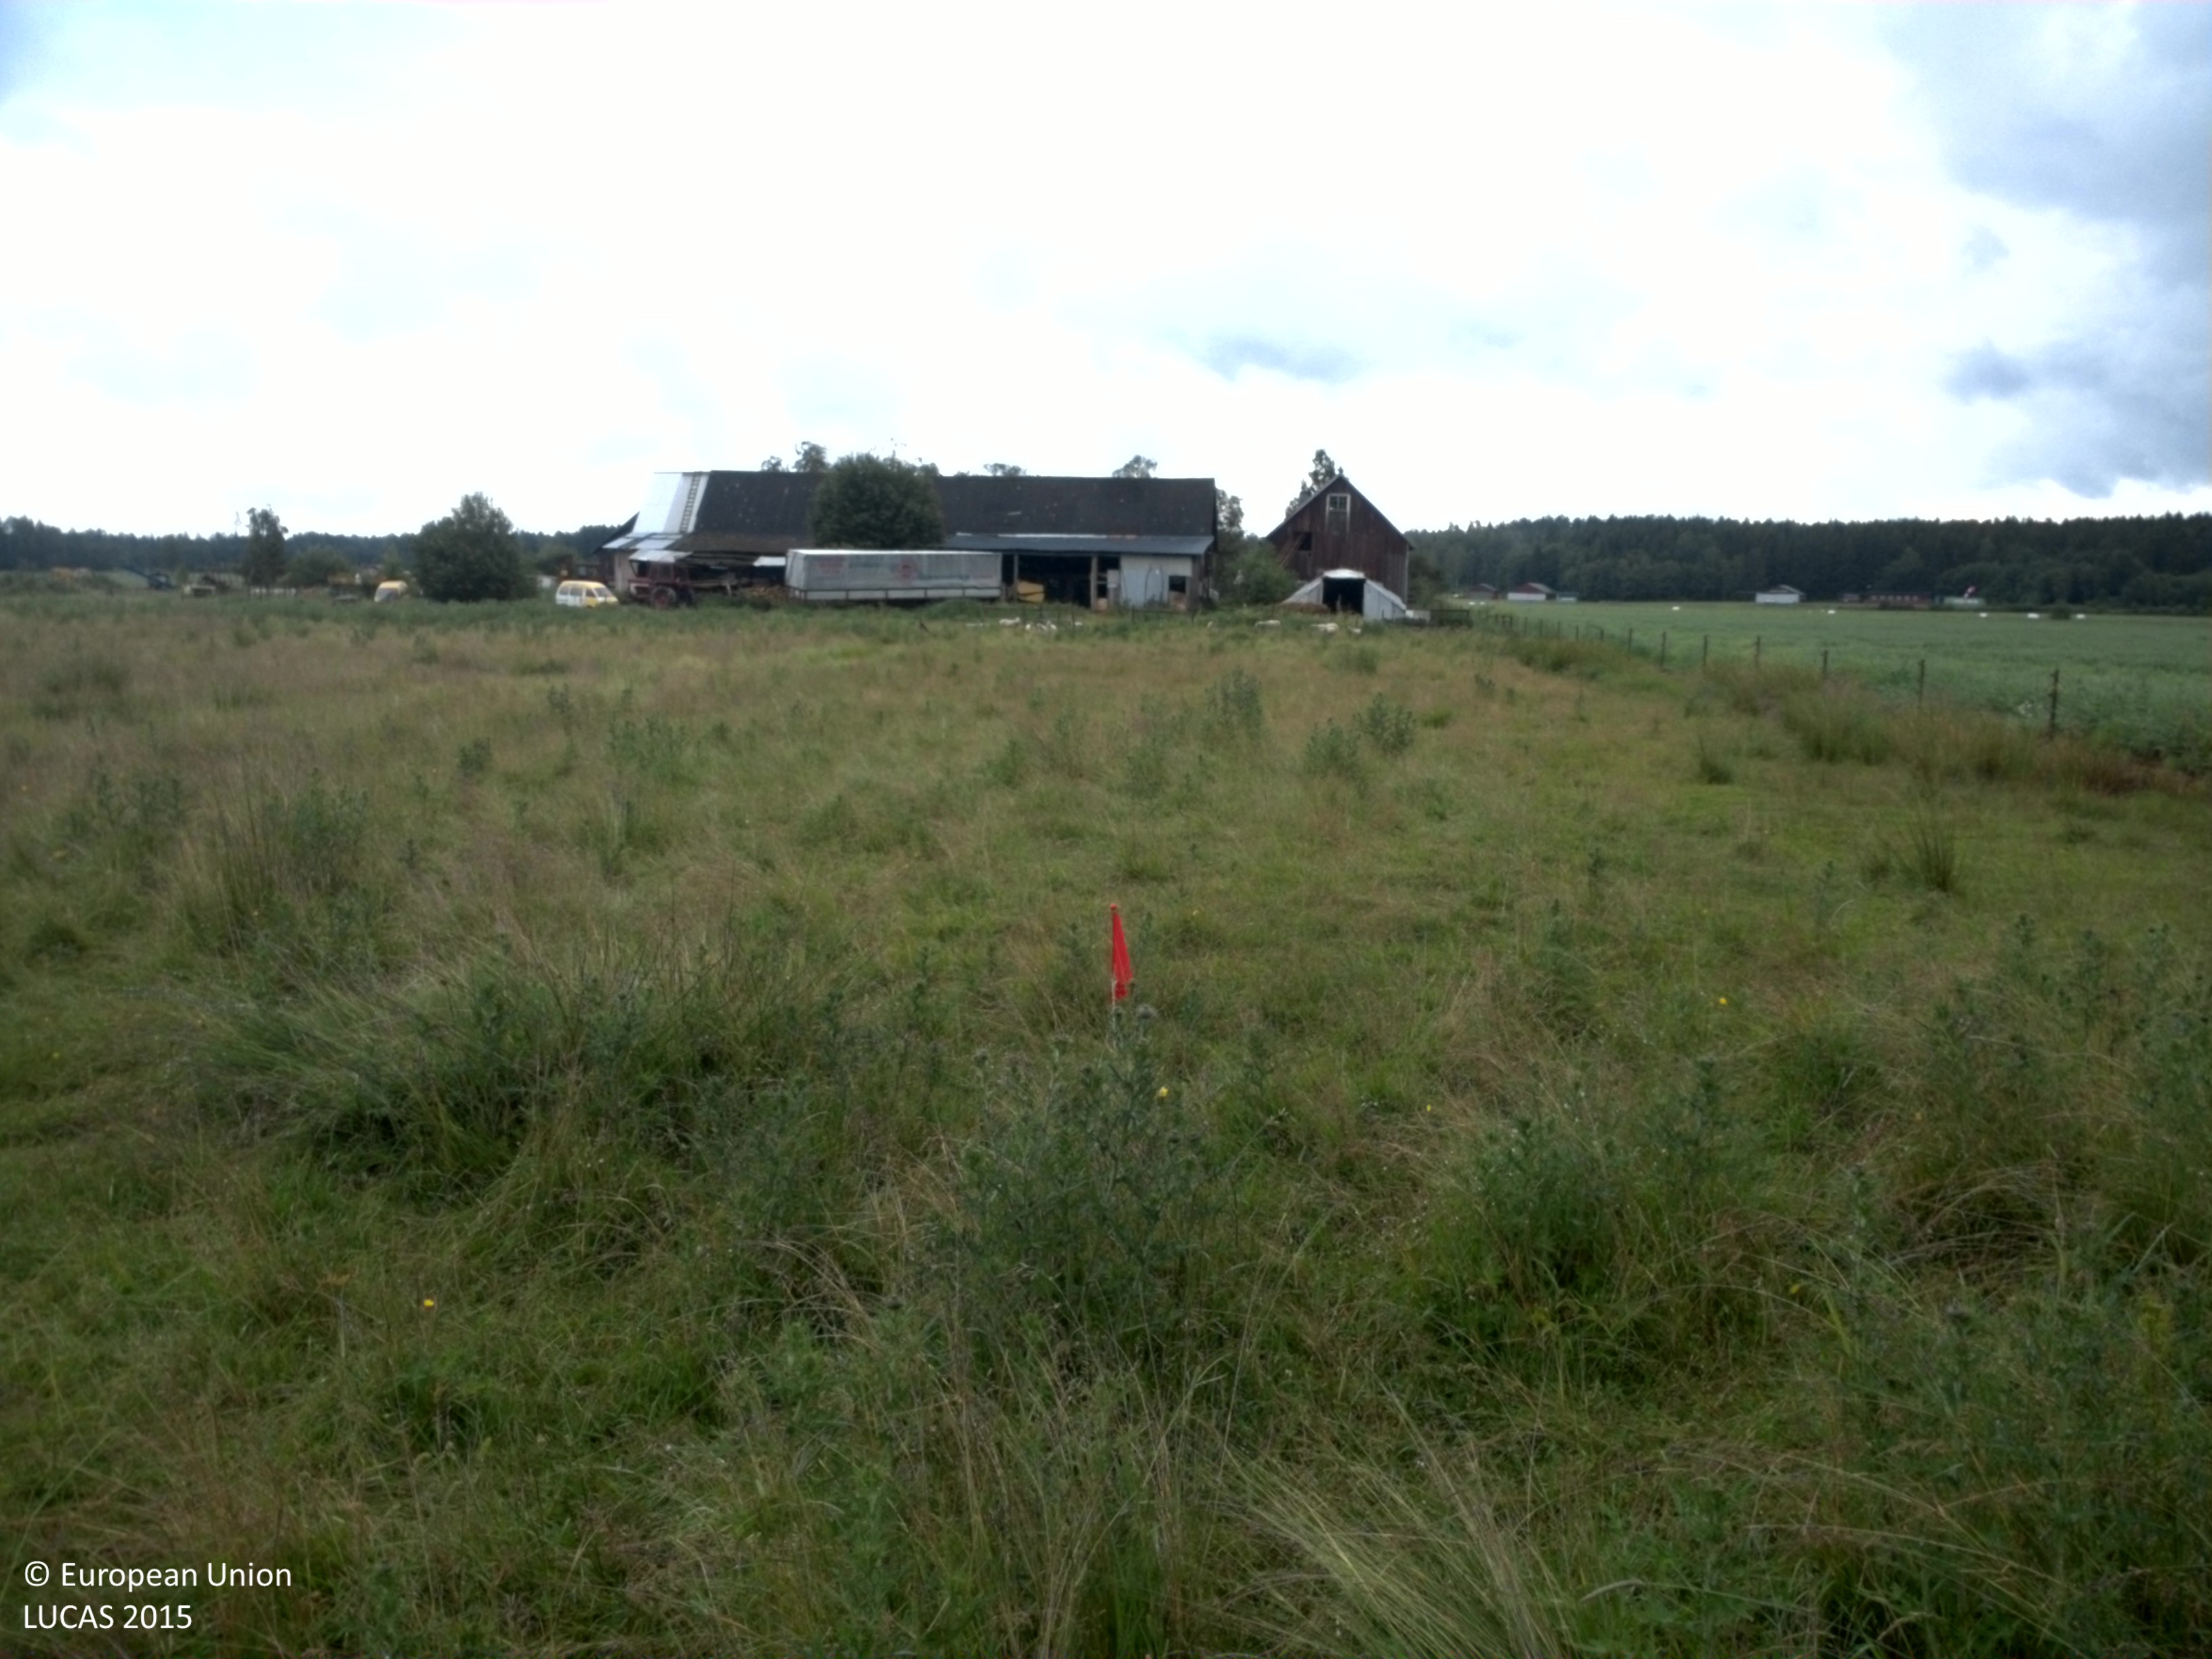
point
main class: Grassland
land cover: Grassland without tree/shrub cover
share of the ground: > 75 %
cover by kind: herbaceous plants 100 %
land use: Agriculture (excluding fallow land and kitchen gardens)
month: July
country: SE
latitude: 58.1963
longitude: 13.9921
